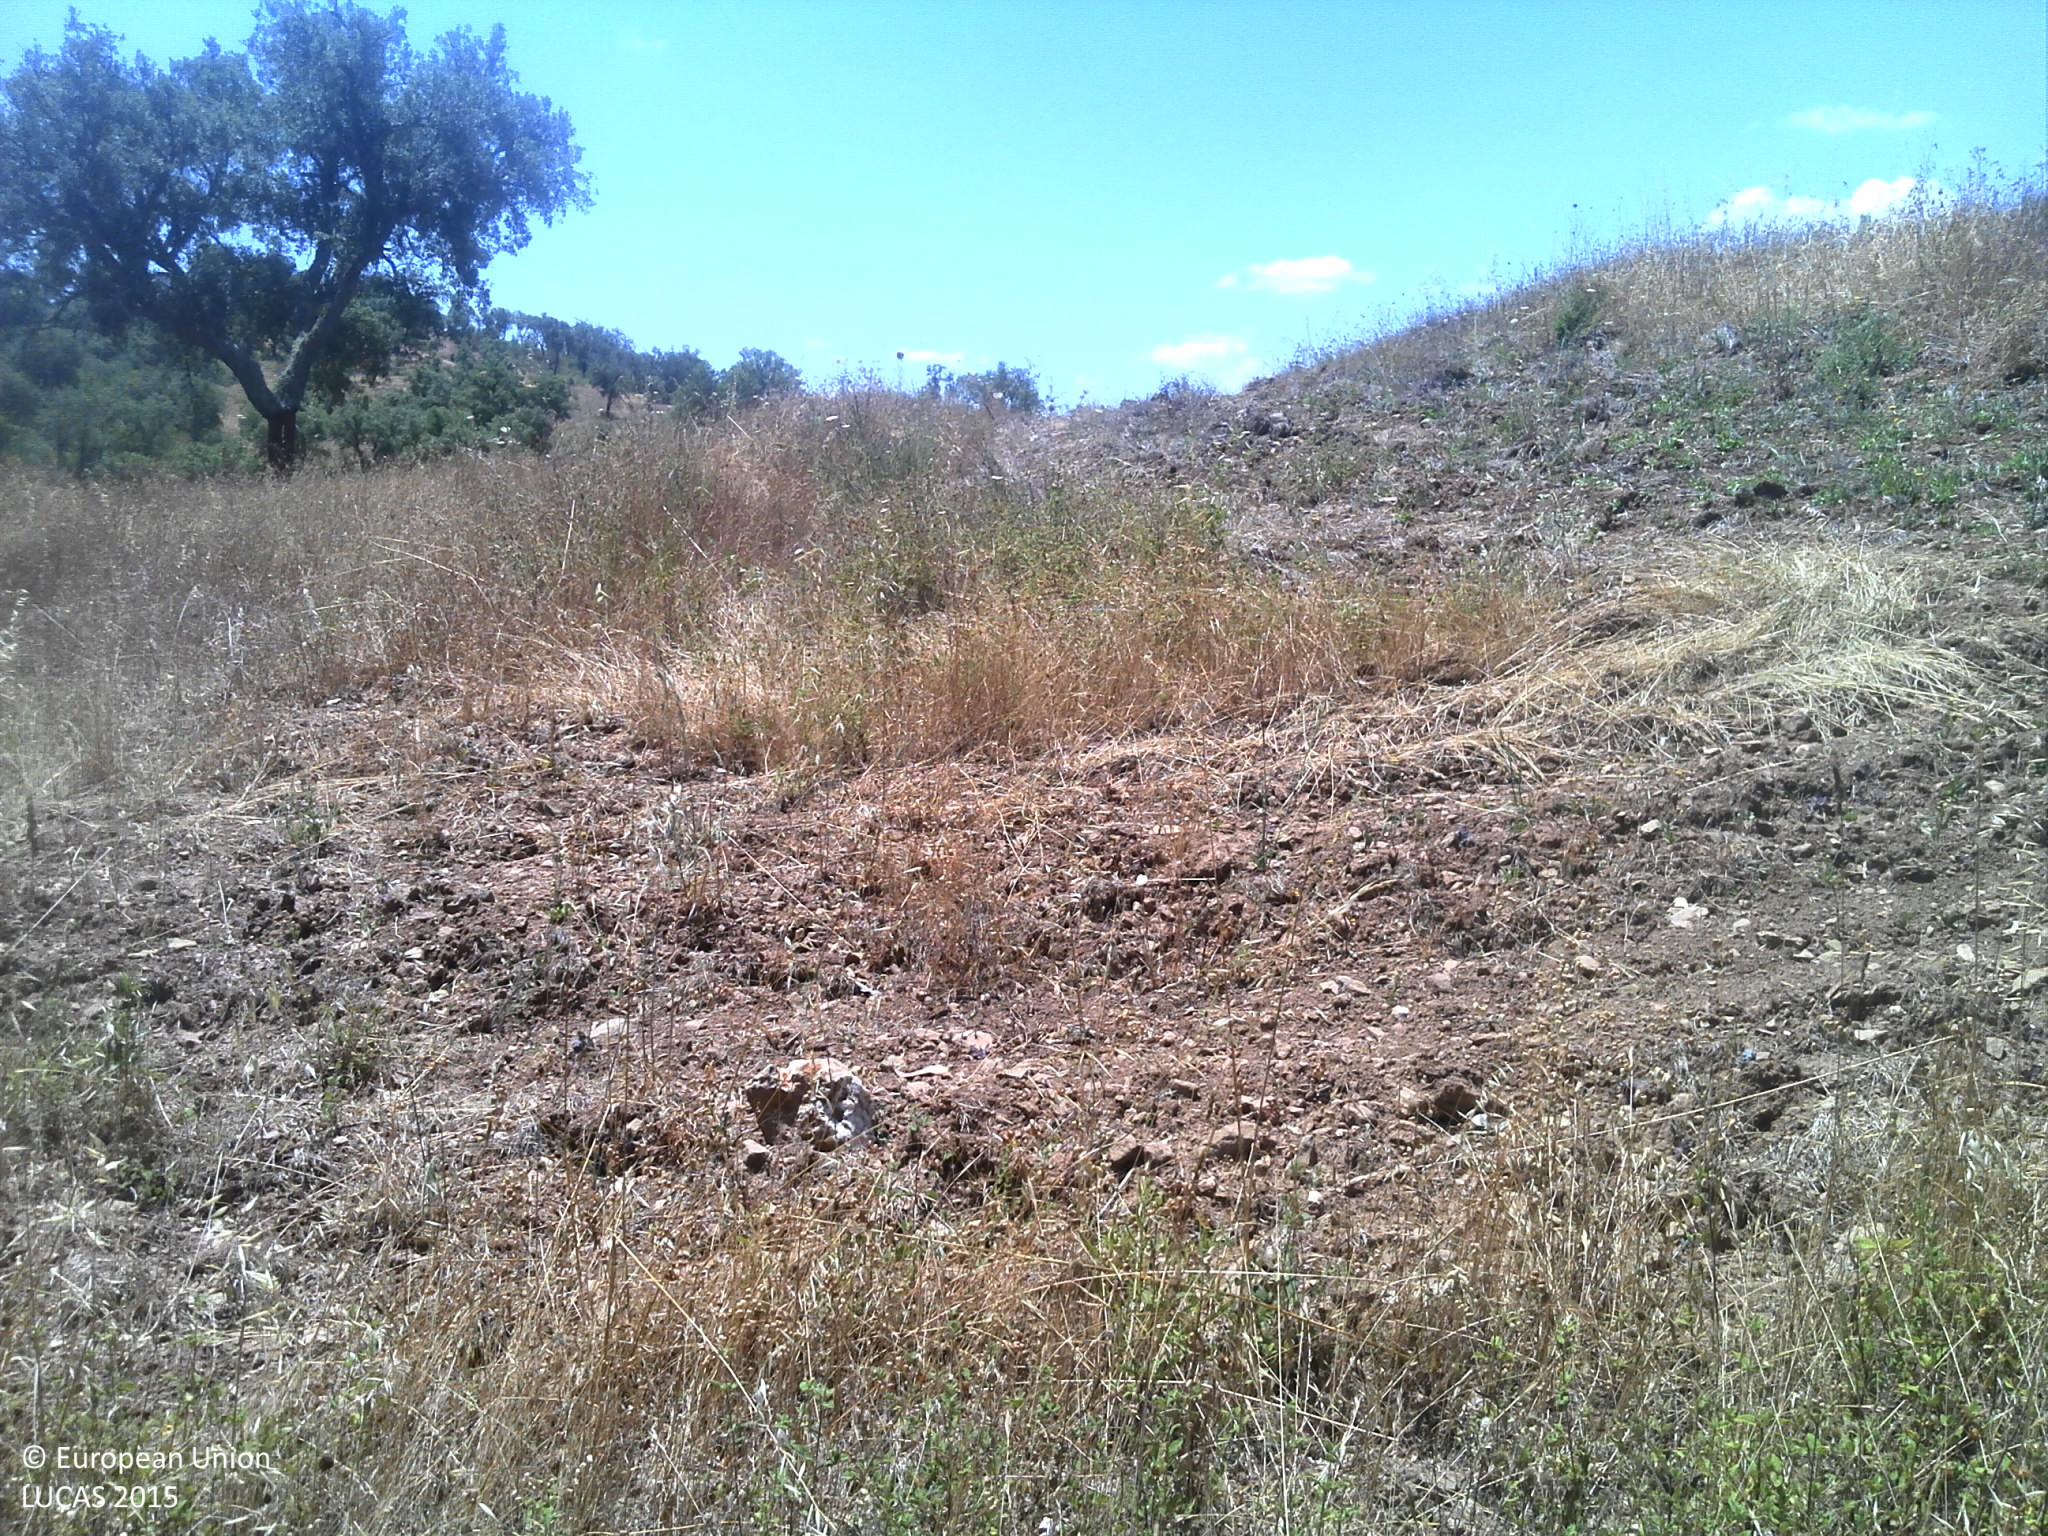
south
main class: Woodland
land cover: Broadleaved woodland
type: broadleaved evergreen forest
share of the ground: 25 - 50 %
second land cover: Shrubland without tree cover
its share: 25 - 50 %
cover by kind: broadleaved forest trees 30 %, herbaceous plants 30 %, shrubs 20 %, unconsolidated bare surface 20 %
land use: Forestry
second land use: Agriculture (excluding fallow land and kitchen gardens)
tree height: > 5 m
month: June
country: PT
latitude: 37.9599
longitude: -8.5619
